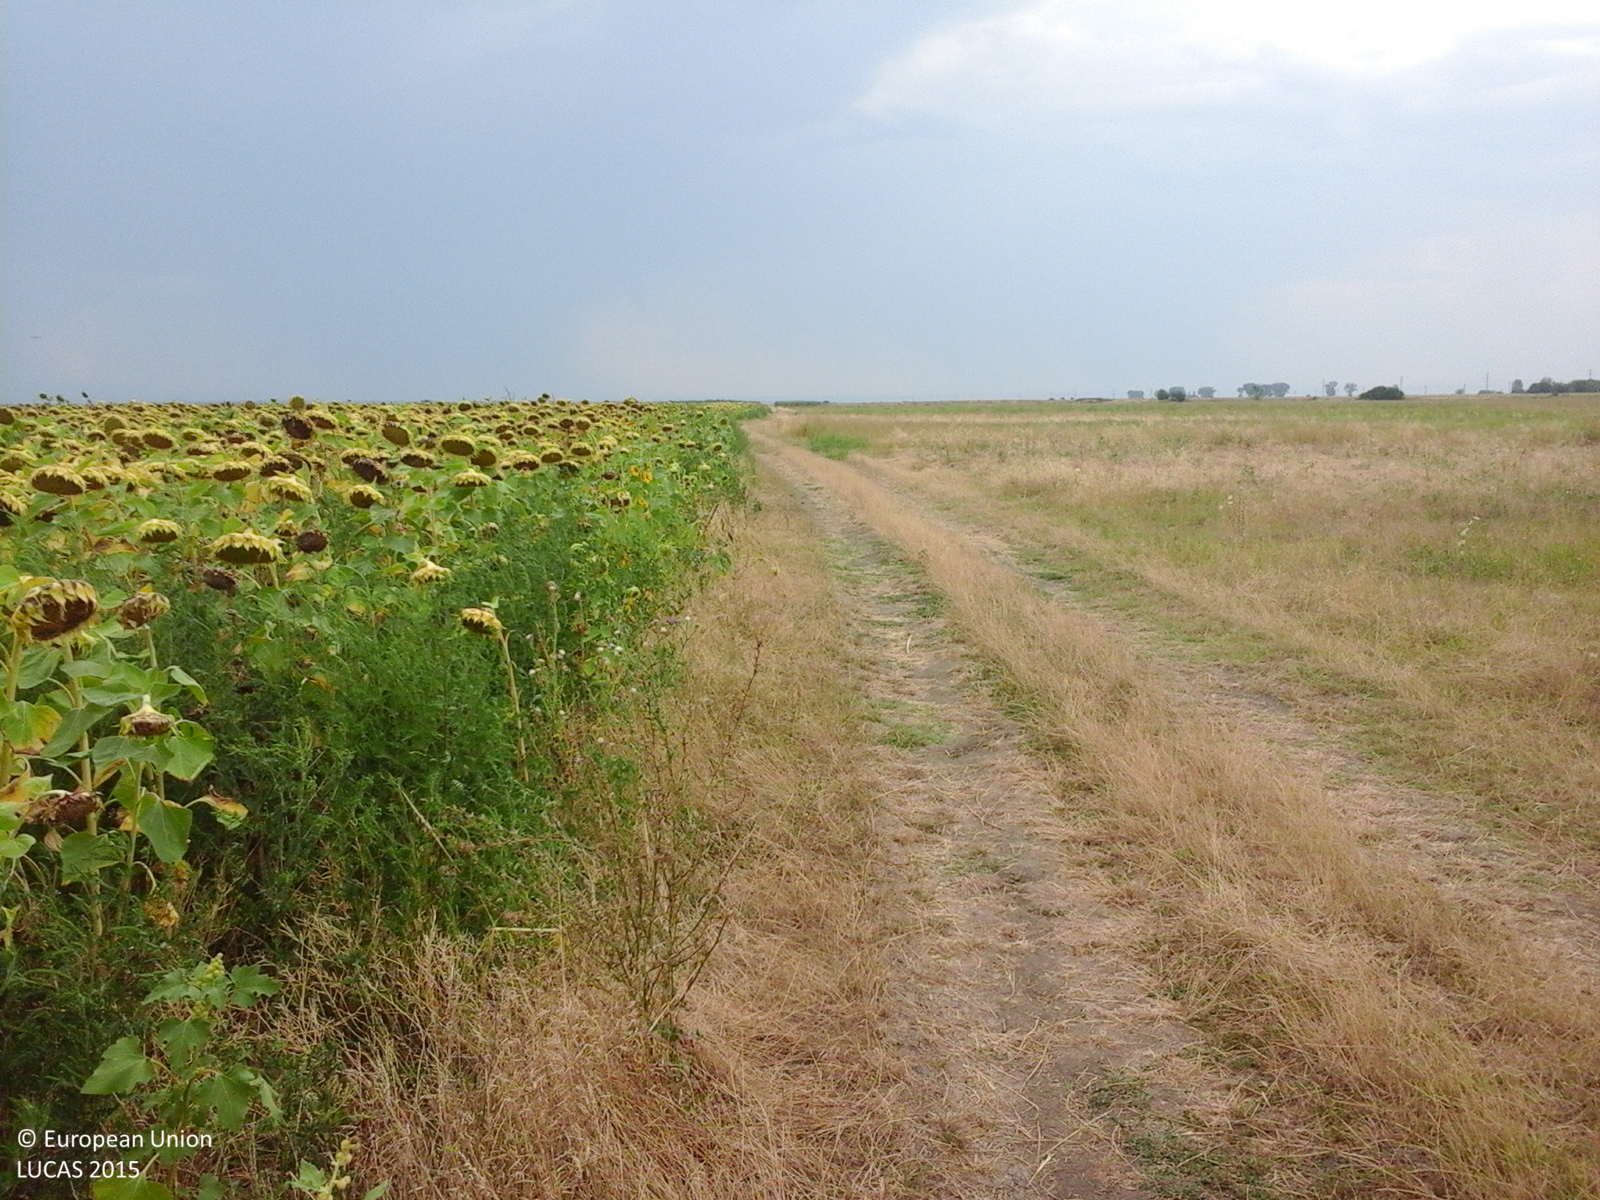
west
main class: Cropland
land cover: Sunflower
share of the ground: > 75 %
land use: Agriculture (excluding fallow land and kitchen gardens)
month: August
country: RO
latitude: 44.4099
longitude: 22.8132
